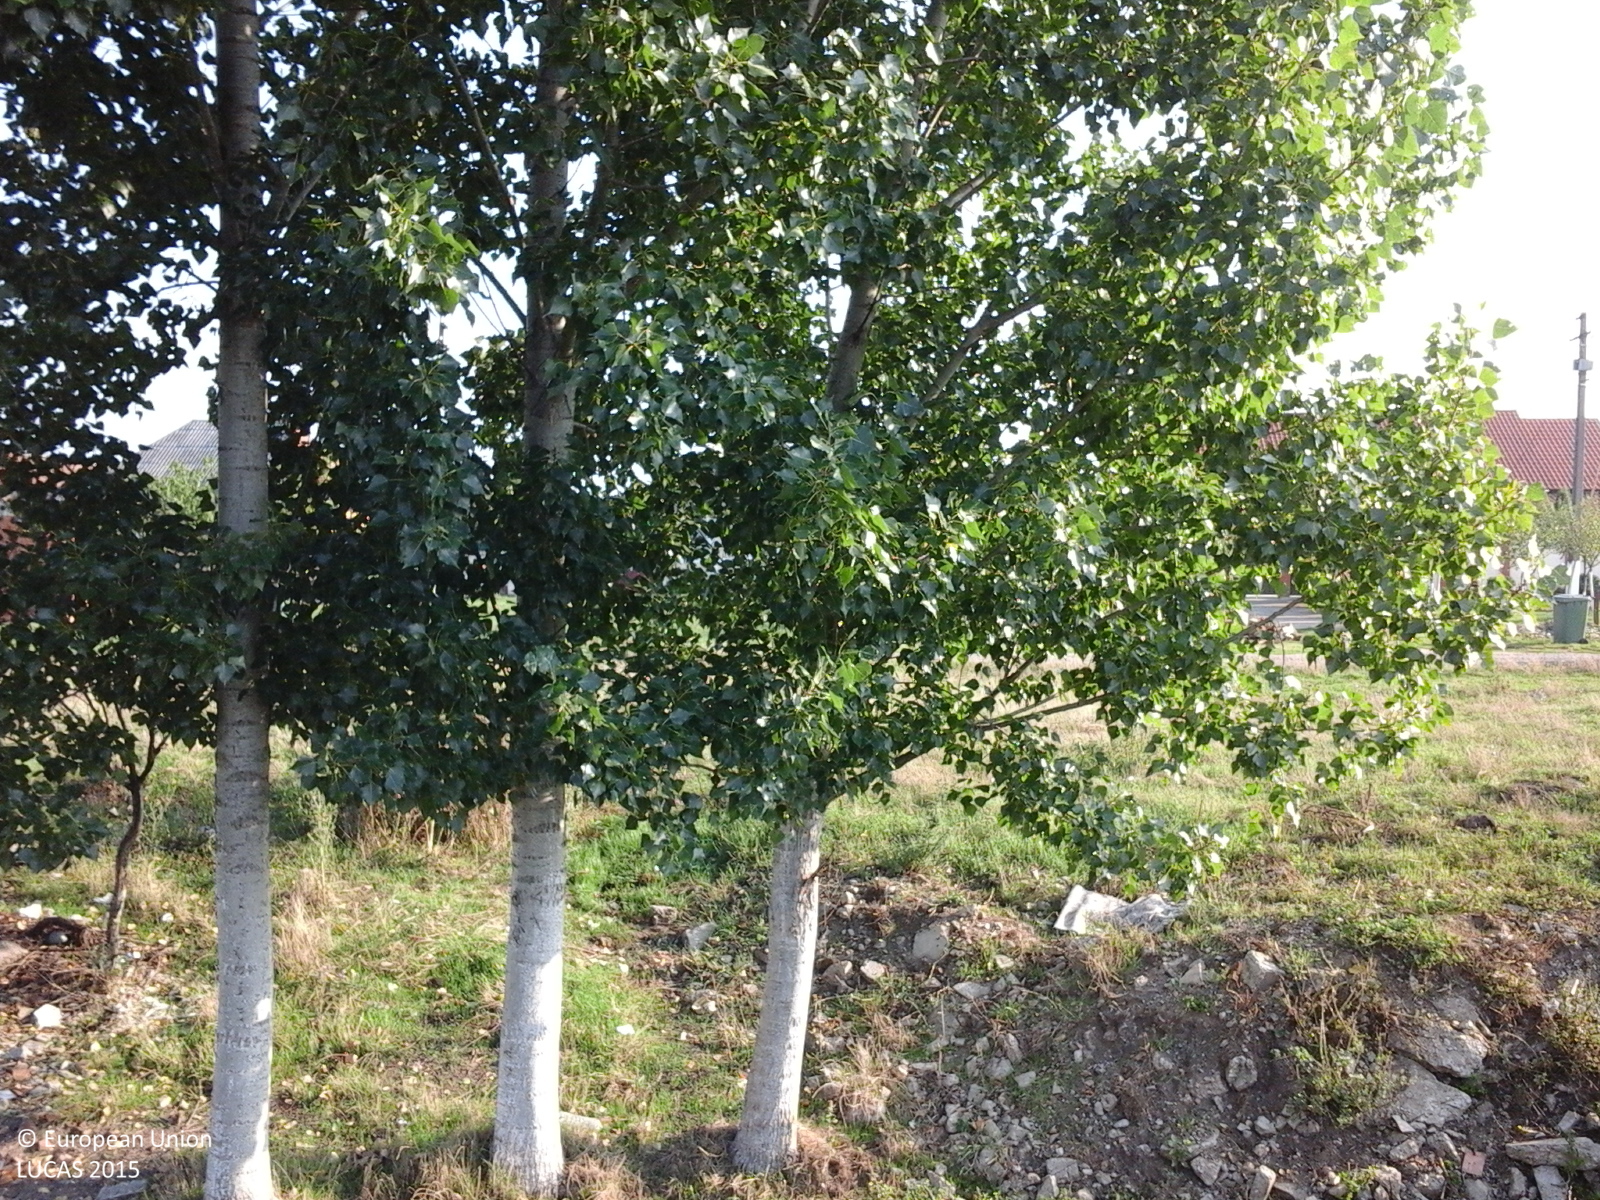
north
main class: Grassland
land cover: Grassland without tree/shrub cover
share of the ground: > 75 %
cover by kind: herbaceous plants 100 %
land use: Agriculture (excluding fallow land and kitchen gardens)
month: August
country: RO
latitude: 46.0971
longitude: 21.4568
